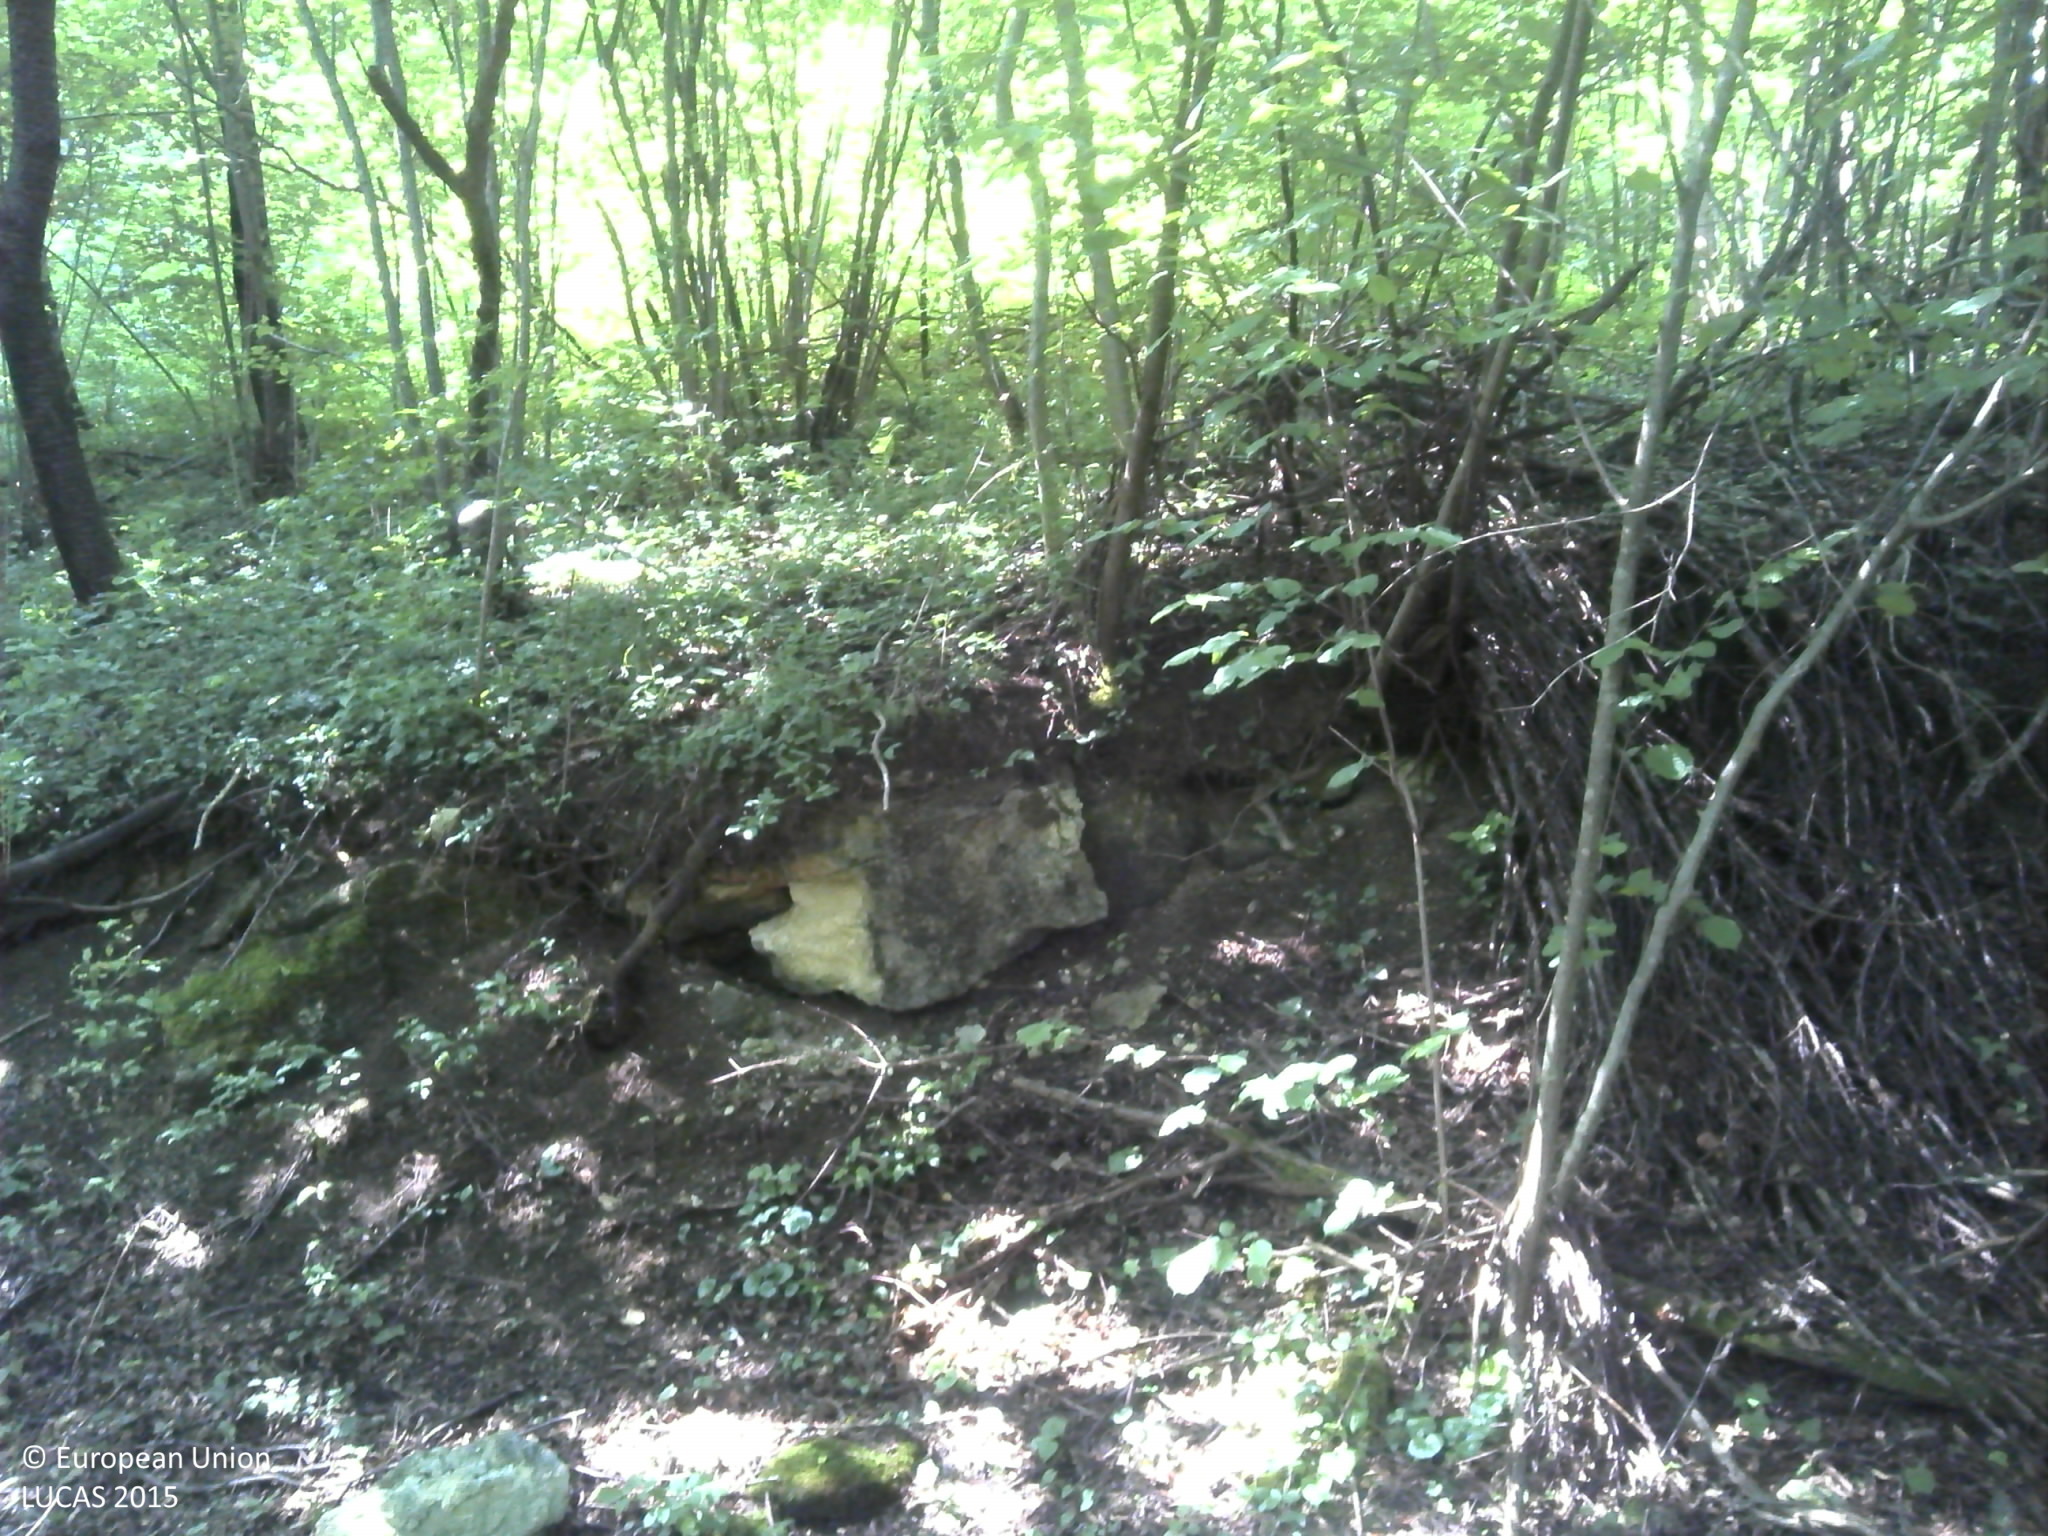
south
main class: Woodland
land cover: Broadleaved woodland
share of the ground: > 75 %
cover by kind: broadleaved forest trees 80 %, lichens and mosses 20 %
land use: Forestry
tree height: < 5 m
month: June
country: HR
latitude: 45.4198
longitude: 17.2206
